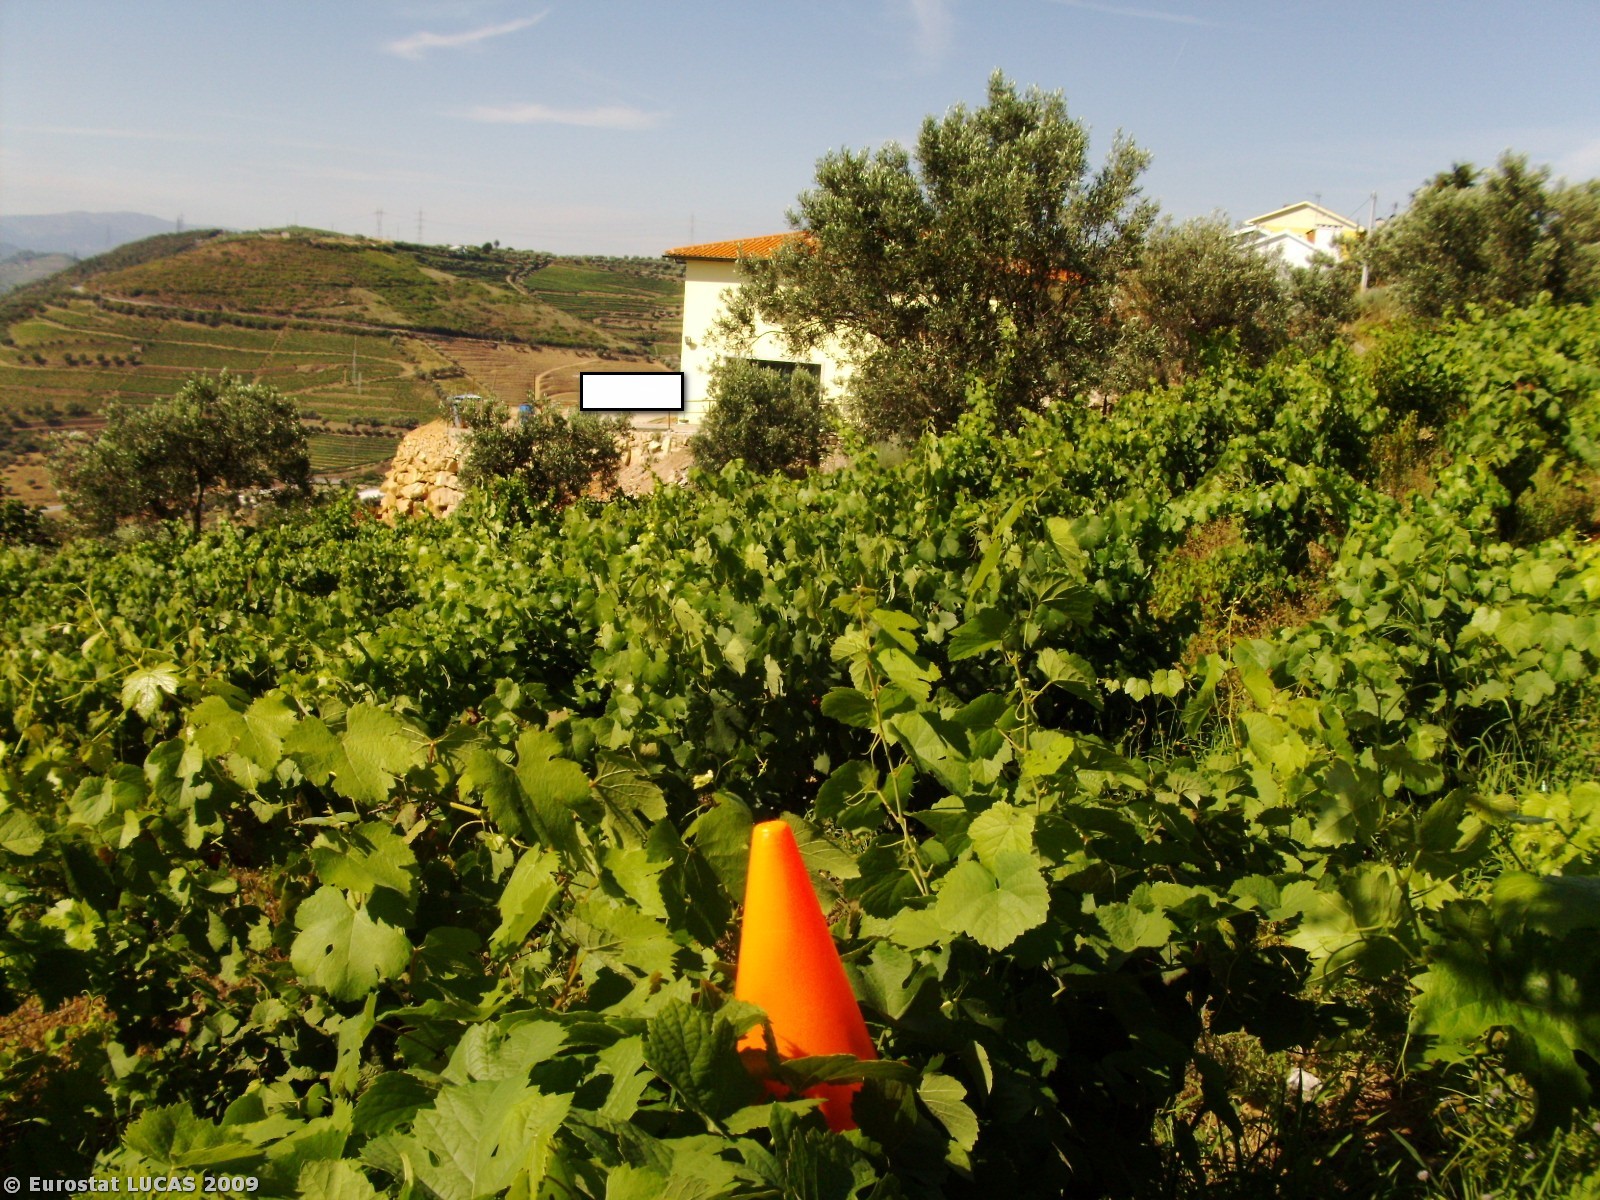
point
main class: Cropland
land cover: Vineyards
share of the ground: 25 - 50 %
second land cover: Bare land
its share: > 75 %
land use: Agriculture (excluding fallow land and kitchen gardens)
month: July
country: PT
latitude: 41.1234
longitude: -7.7681
